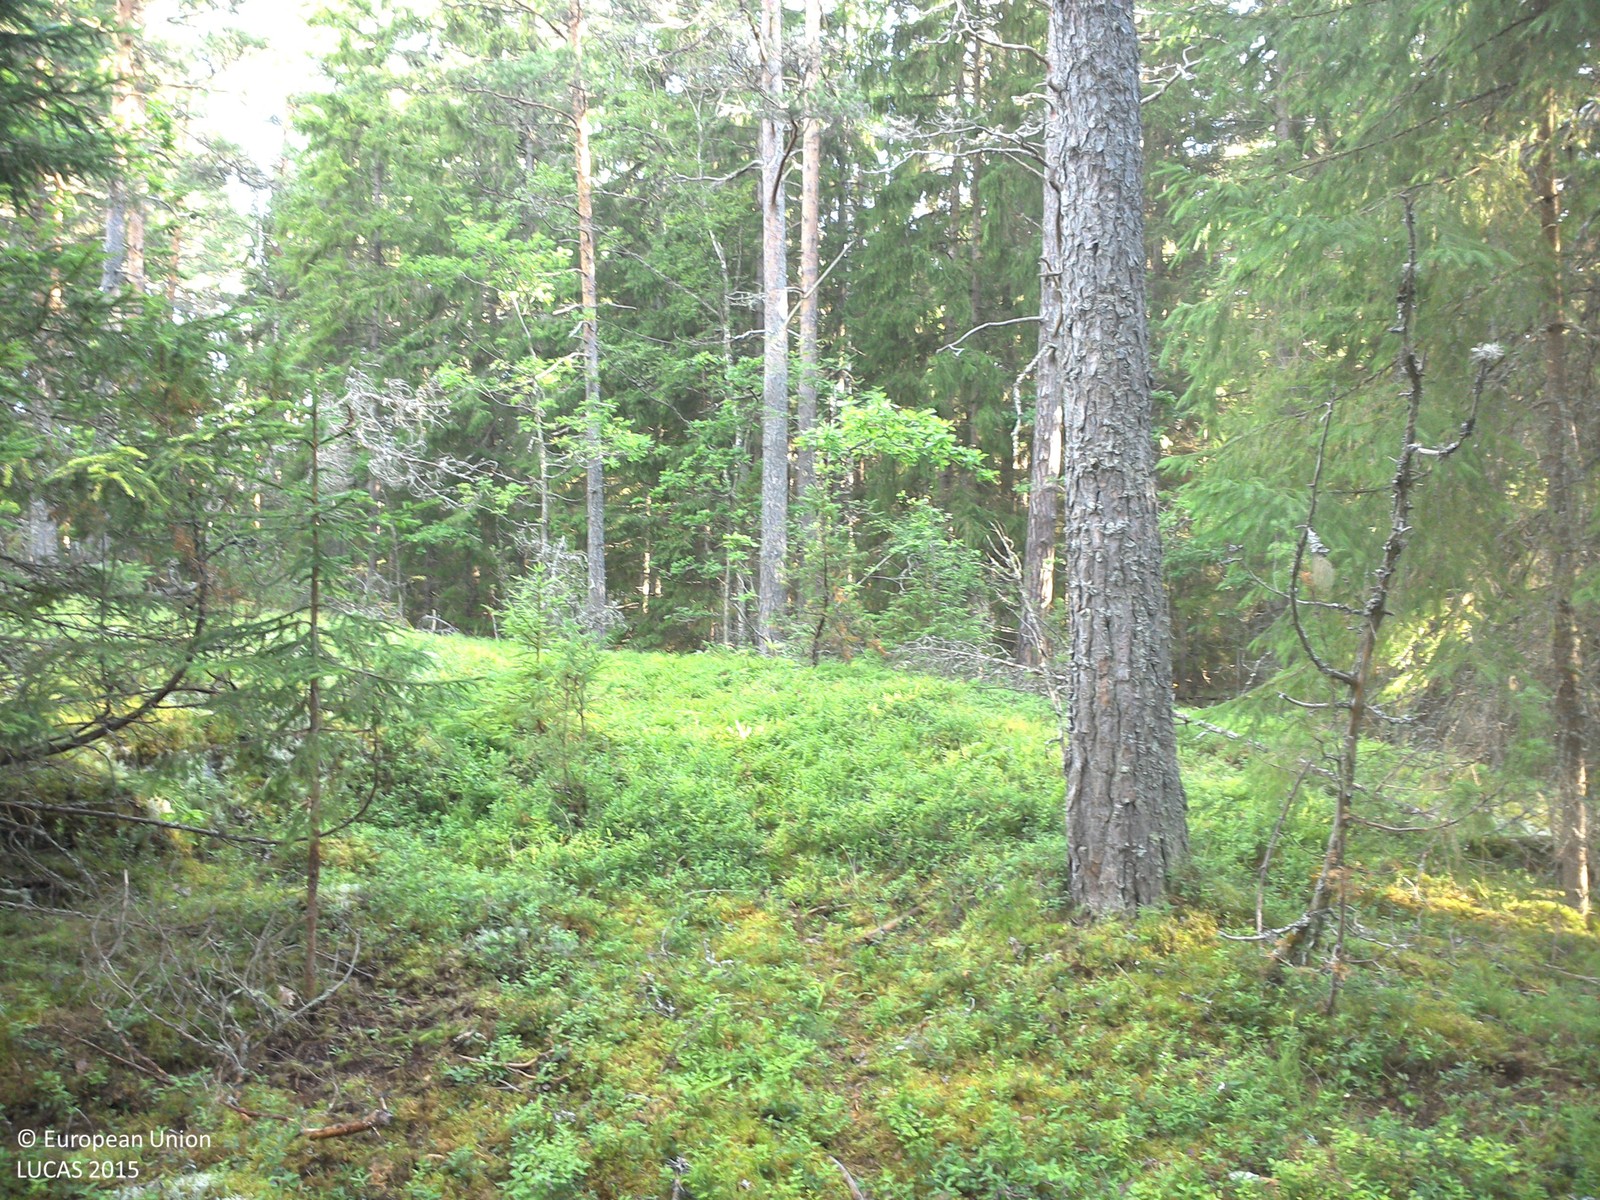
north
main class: Woodland
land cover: Spruce dominated coniferous woodland
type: boreal forest
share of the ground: 50 - 75 %
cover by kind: coniferous forest trees 60 %, herbaceous plants 20 %, lichens and mosses 20 %
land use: Forestry
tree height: > 5 m
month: July
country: SE
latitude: 57.7175
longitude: 16.1585
